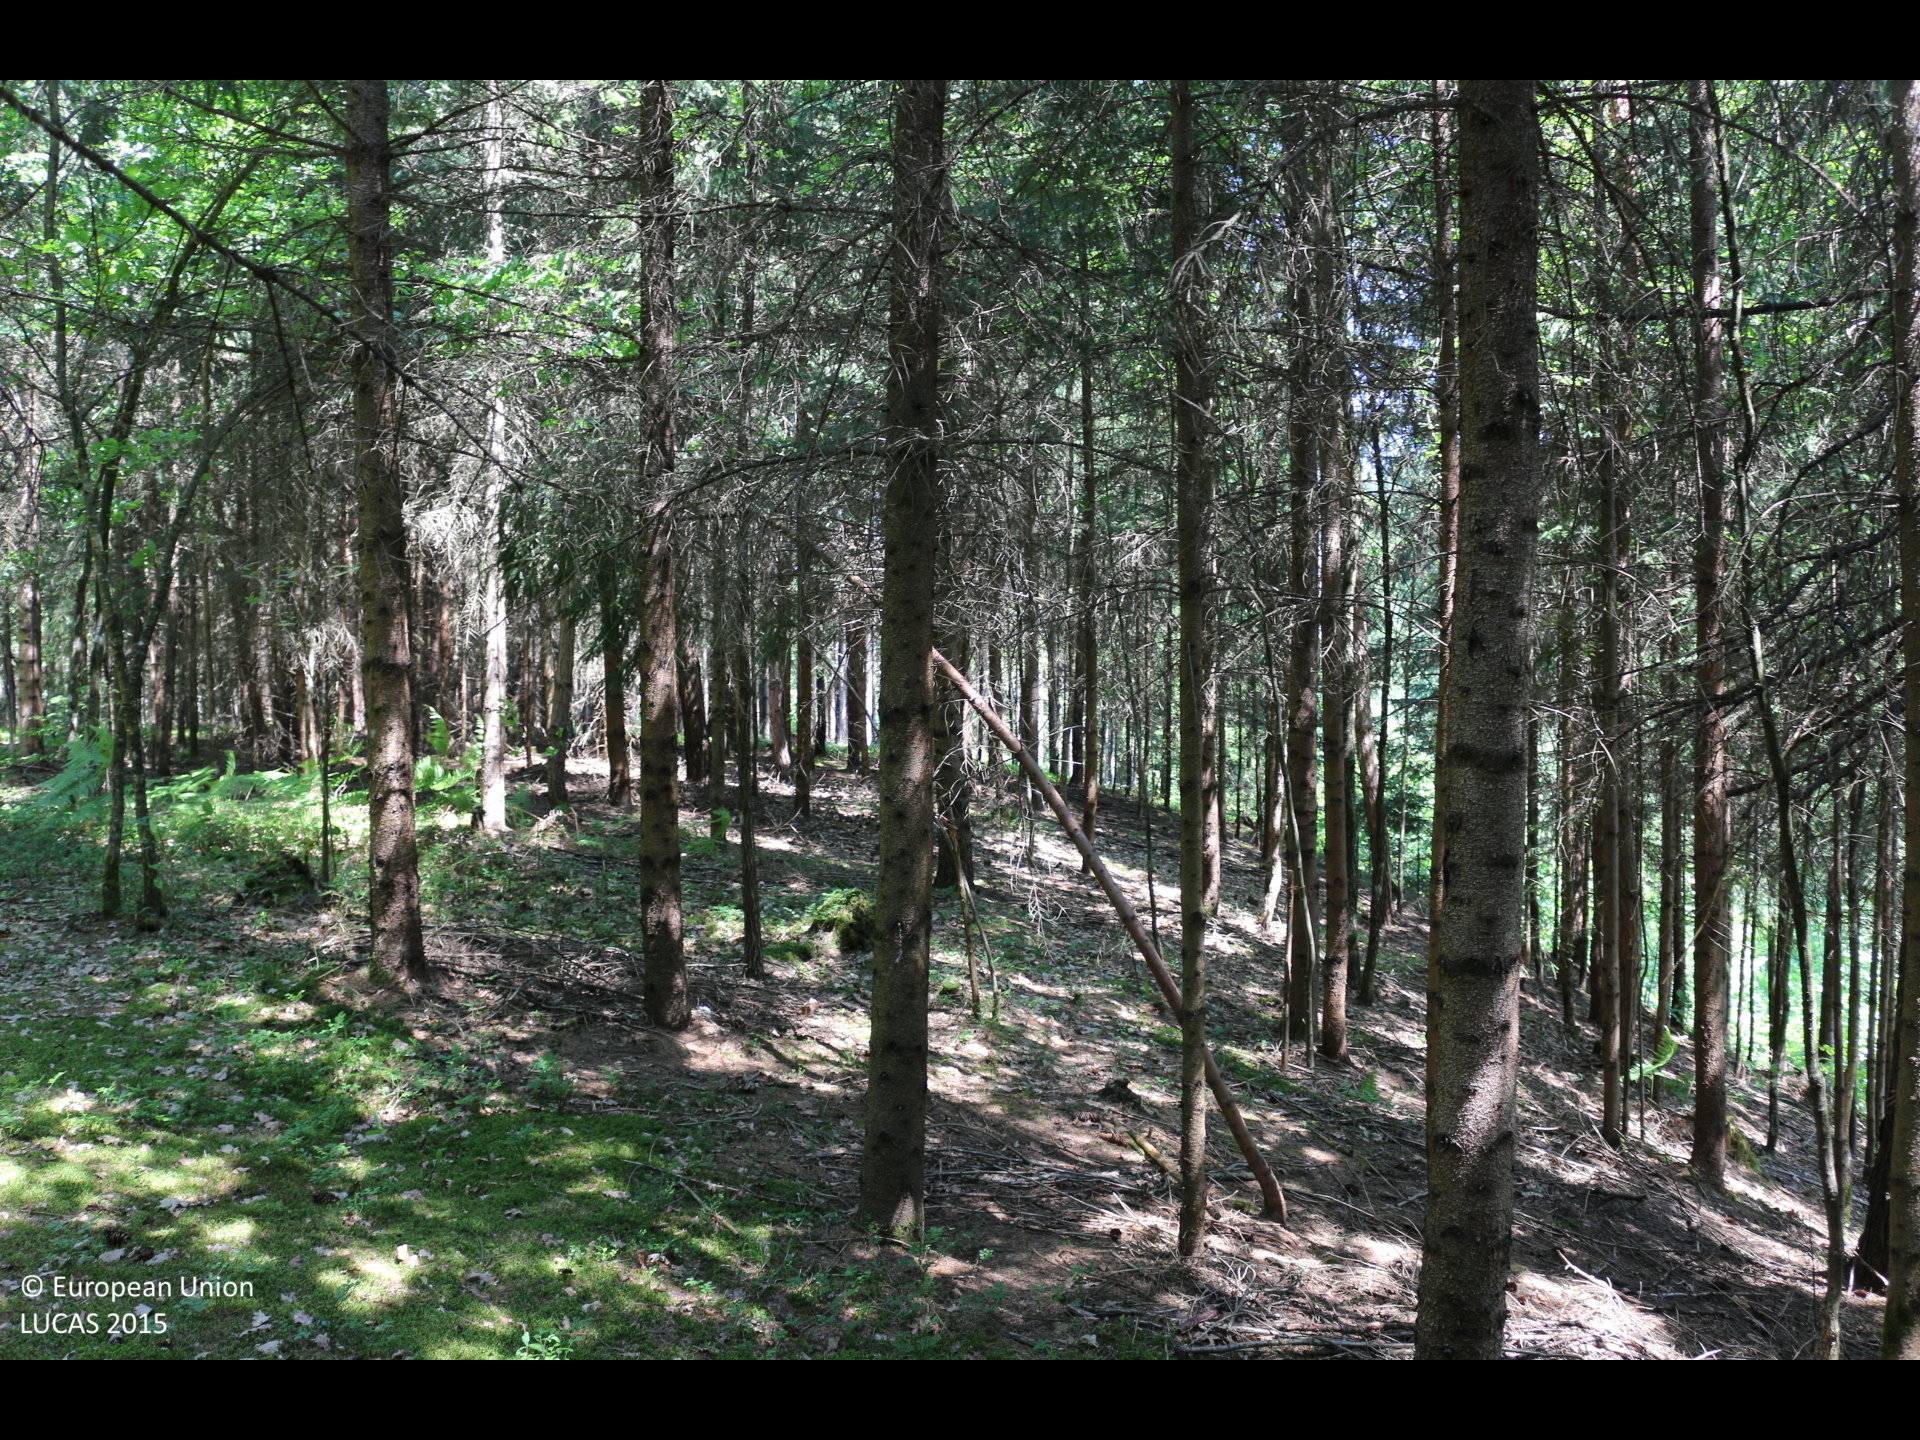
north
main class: Woodland
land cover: Spruce dominated coniferous woodland
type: alpine coniferous forest
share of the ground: > 75 %
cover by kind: coniferous forest trees 90 %, broadleaved forest trees 10 %
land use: Forestry
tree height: > 5 m
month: June
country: AT
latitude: 46.7047
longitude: 14.1175
